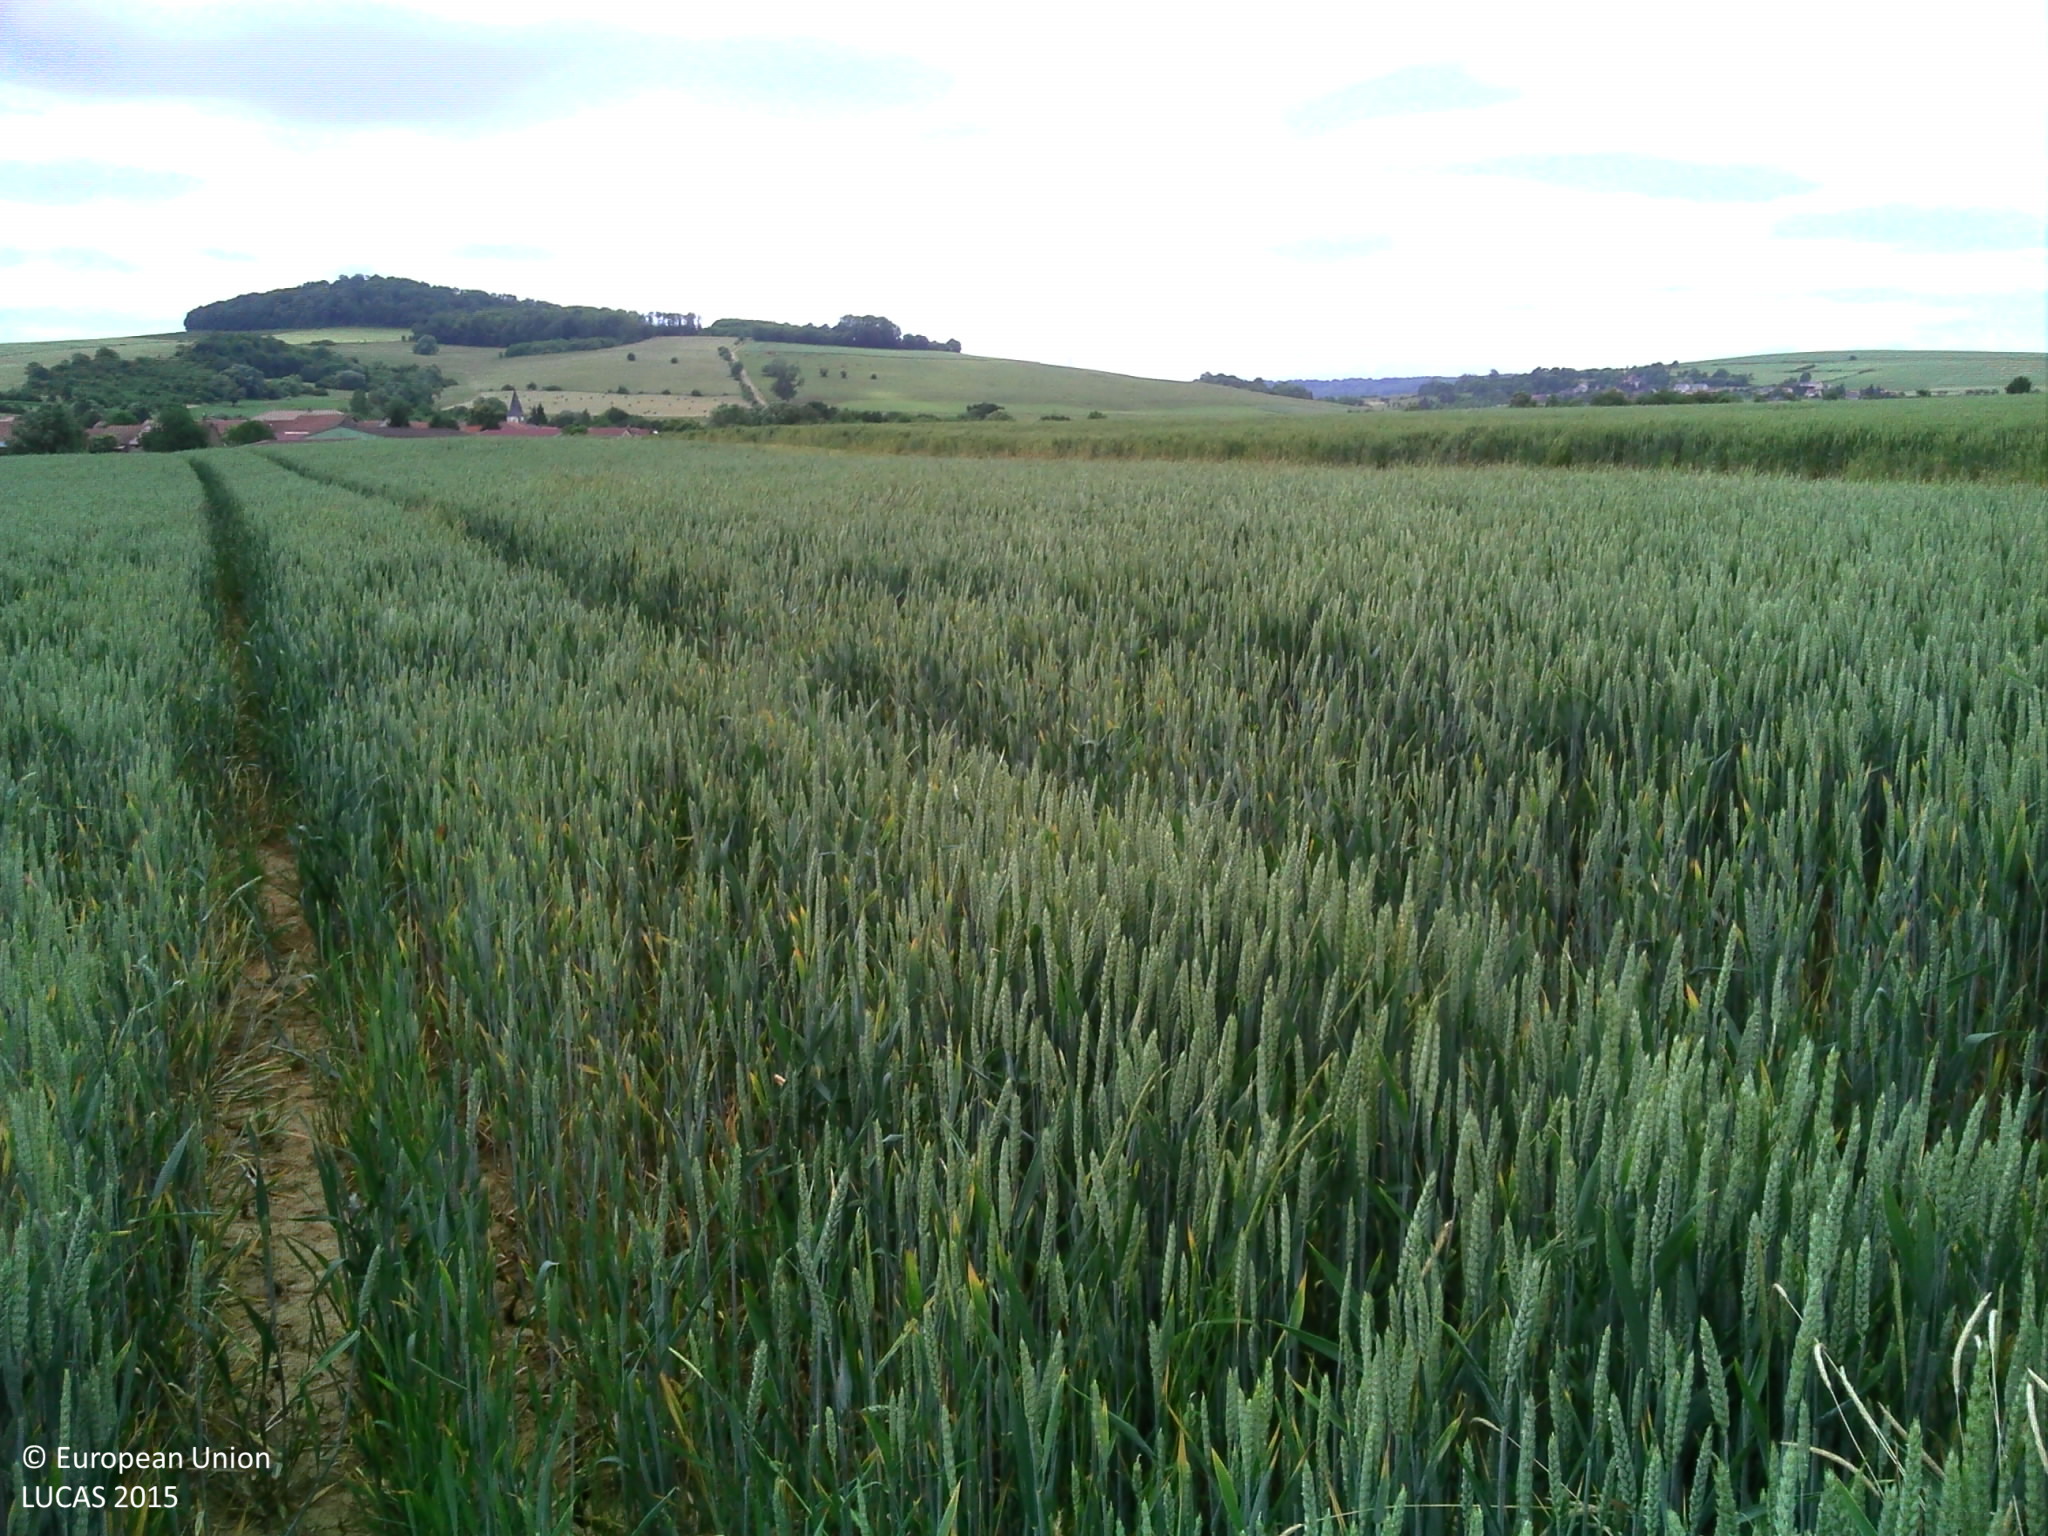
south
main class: Cropland
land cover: Common wheat
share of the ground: > 75 %
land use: Agriculture (excluding fallow land and kitchen gardens)
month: June
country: FR
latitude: 48.8605
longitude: 6.1969
